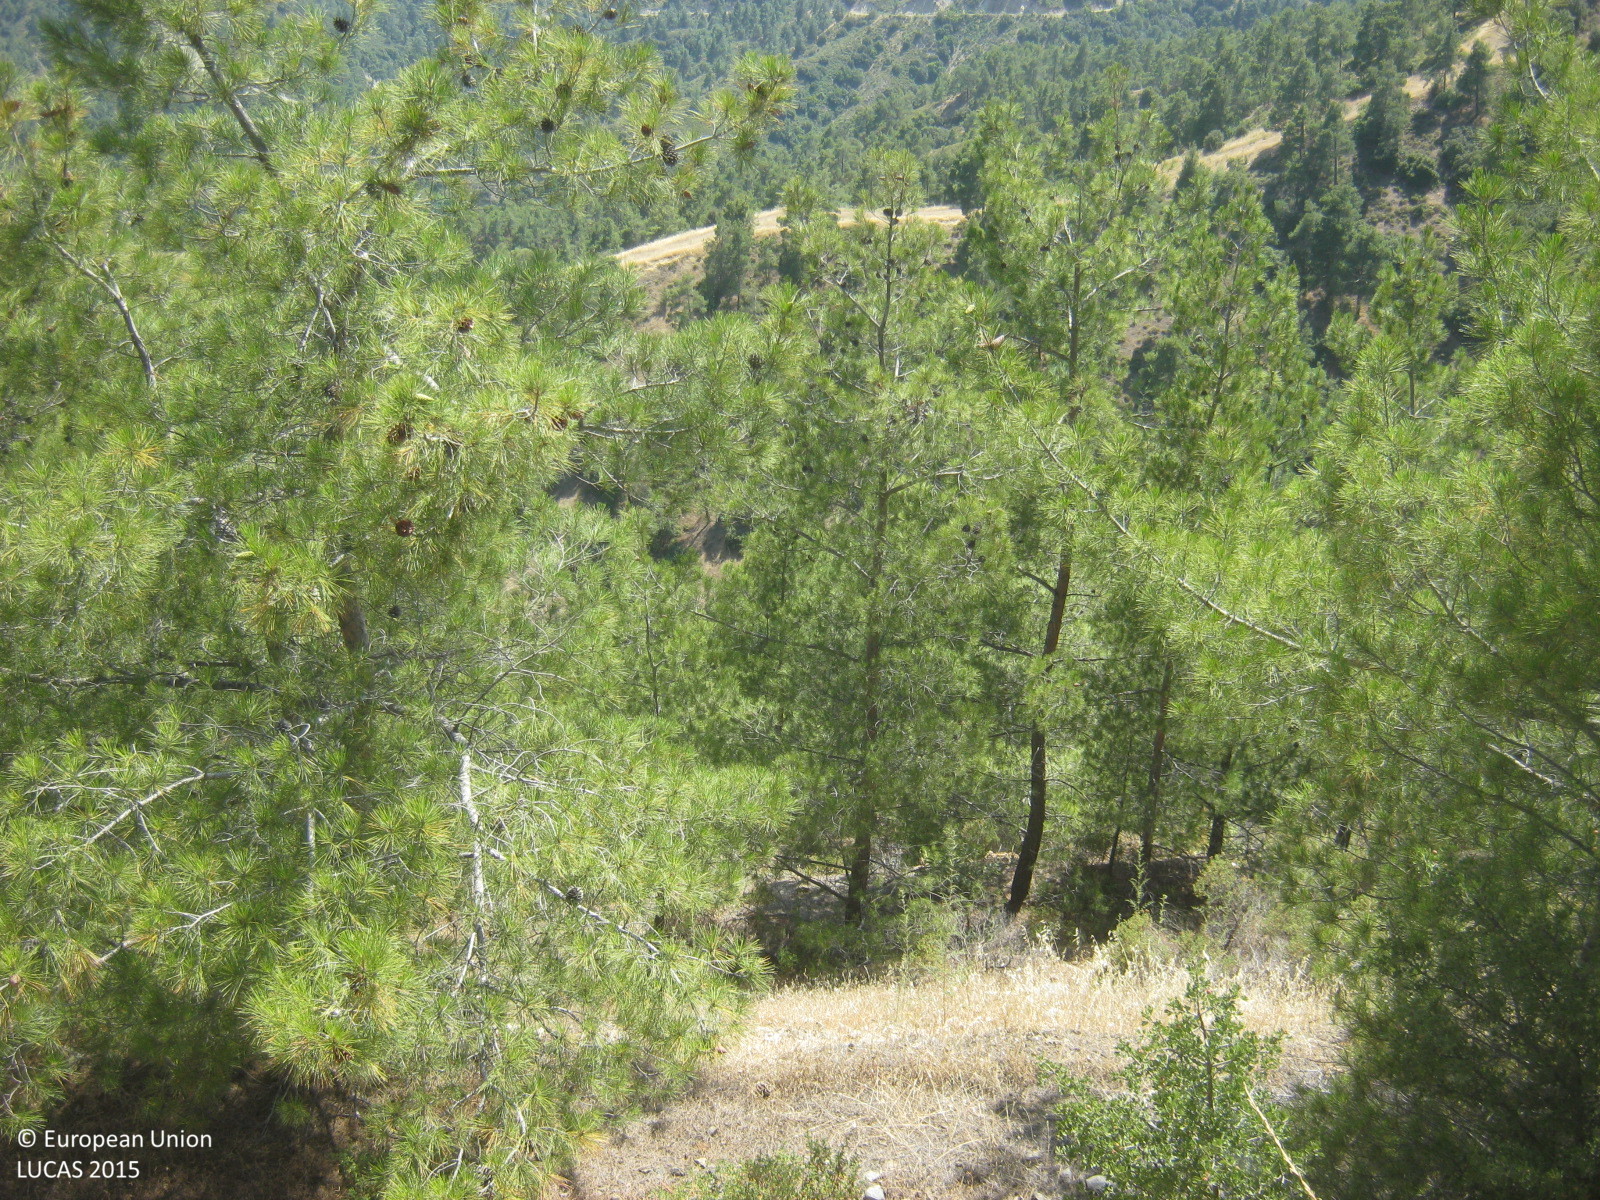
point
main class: Woodland
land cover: Pine dominated coniferous woodland
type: coniferous forest of the mediterranean region
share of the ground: 25 - 50 %
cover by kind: coniferous forest trees 50 %, shrubs 20 %, herbaceous plants 15 %, unconsolidated bare surface 15 %
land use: Forestry
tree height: > 5 m
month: June
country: CY
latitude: 35.0159
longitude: 32.8650
